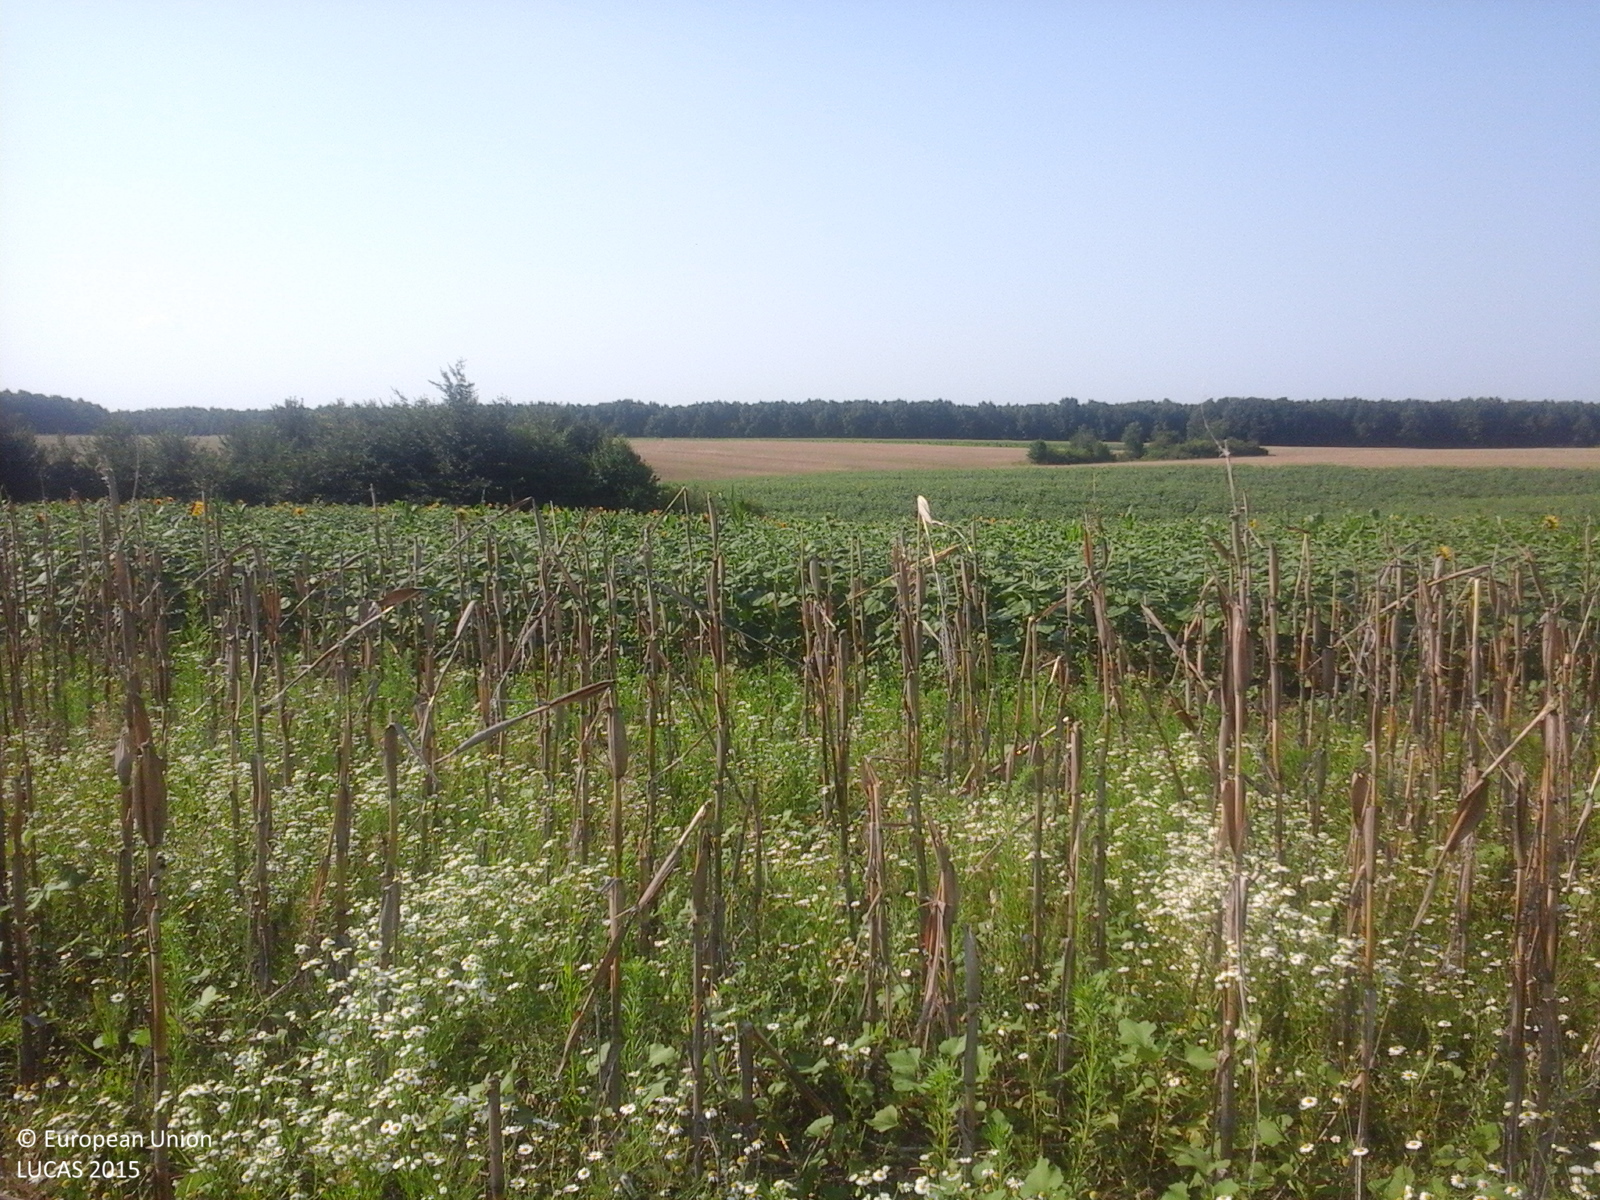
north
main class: Grassland
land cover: Spontaneously vegetated surfaces
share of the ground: > 75 %
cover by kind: herbaceous plants 100 %
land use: Fallow land
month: July
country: RO
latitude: 44.5329
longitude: 24.7621
